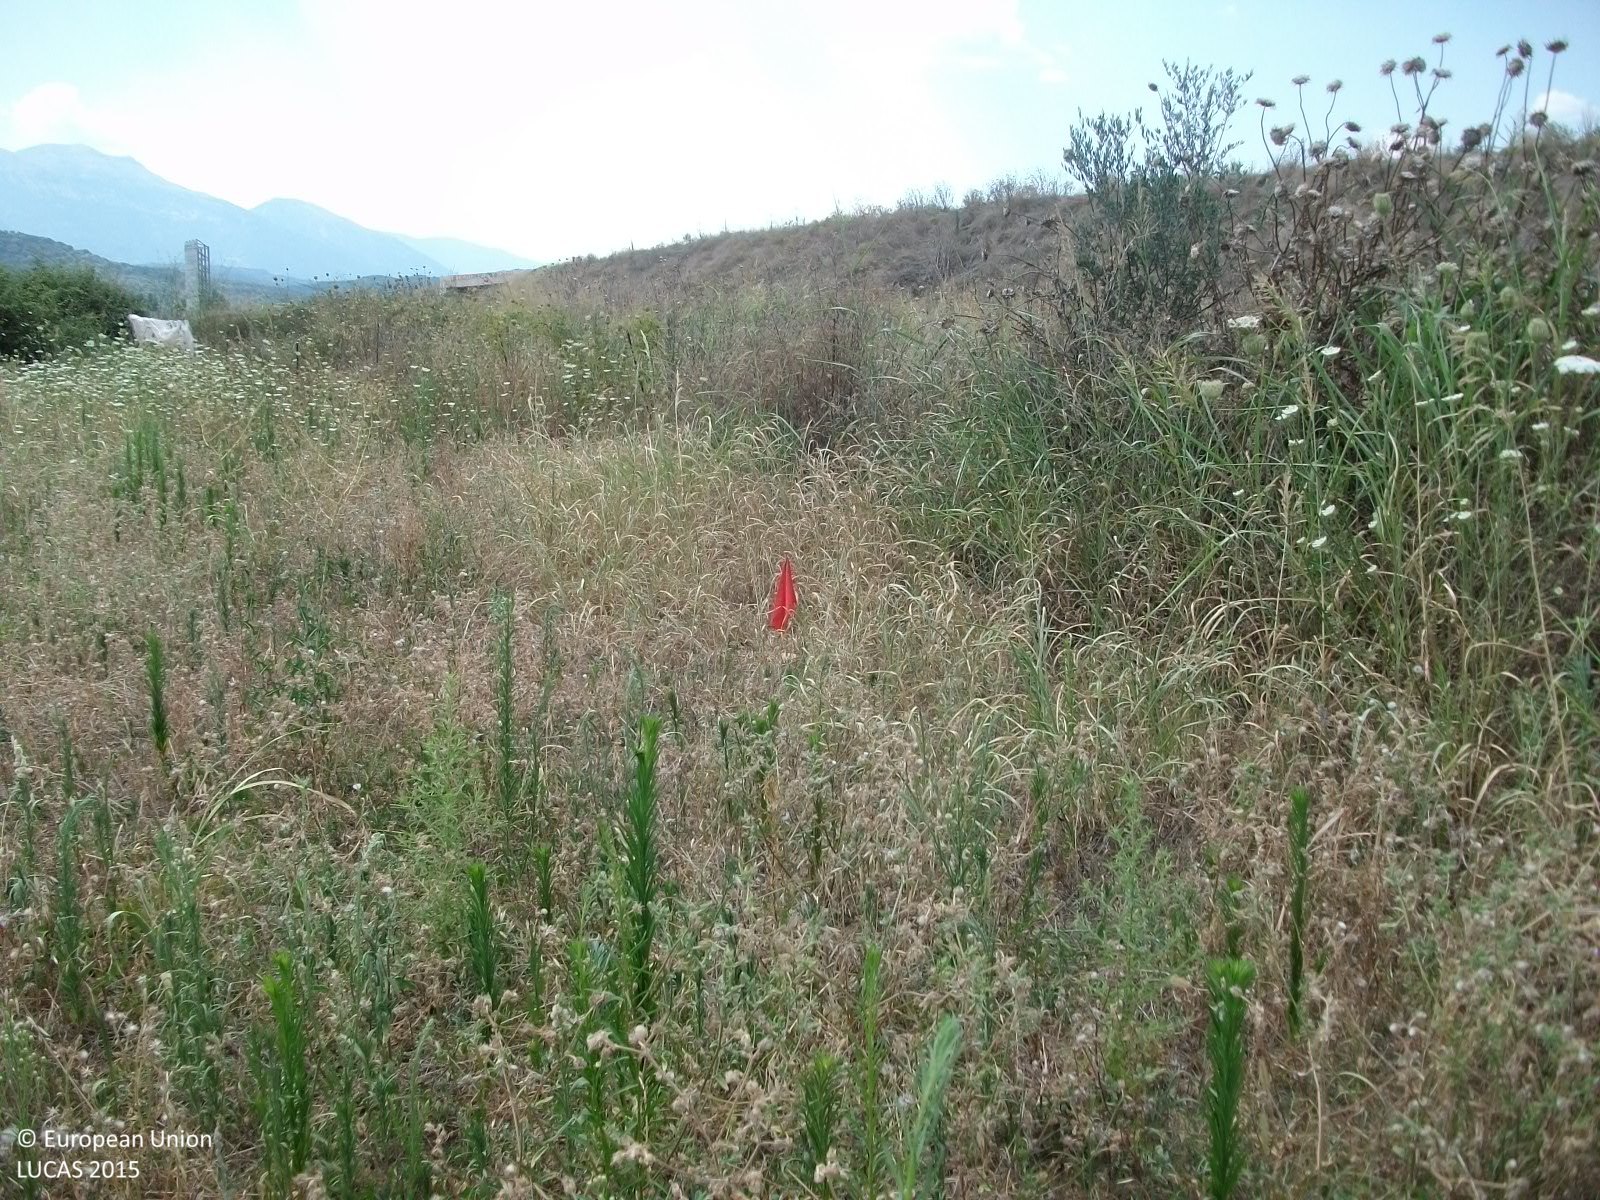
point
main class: Grassland
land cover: Spontaneously vegetated surfaces
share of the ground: > 75 %
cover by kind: herbaceous plants 95 %, shrubs 5 %
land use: Fallow land
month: July
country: GR
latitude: 37.0931
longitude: 22.4334
